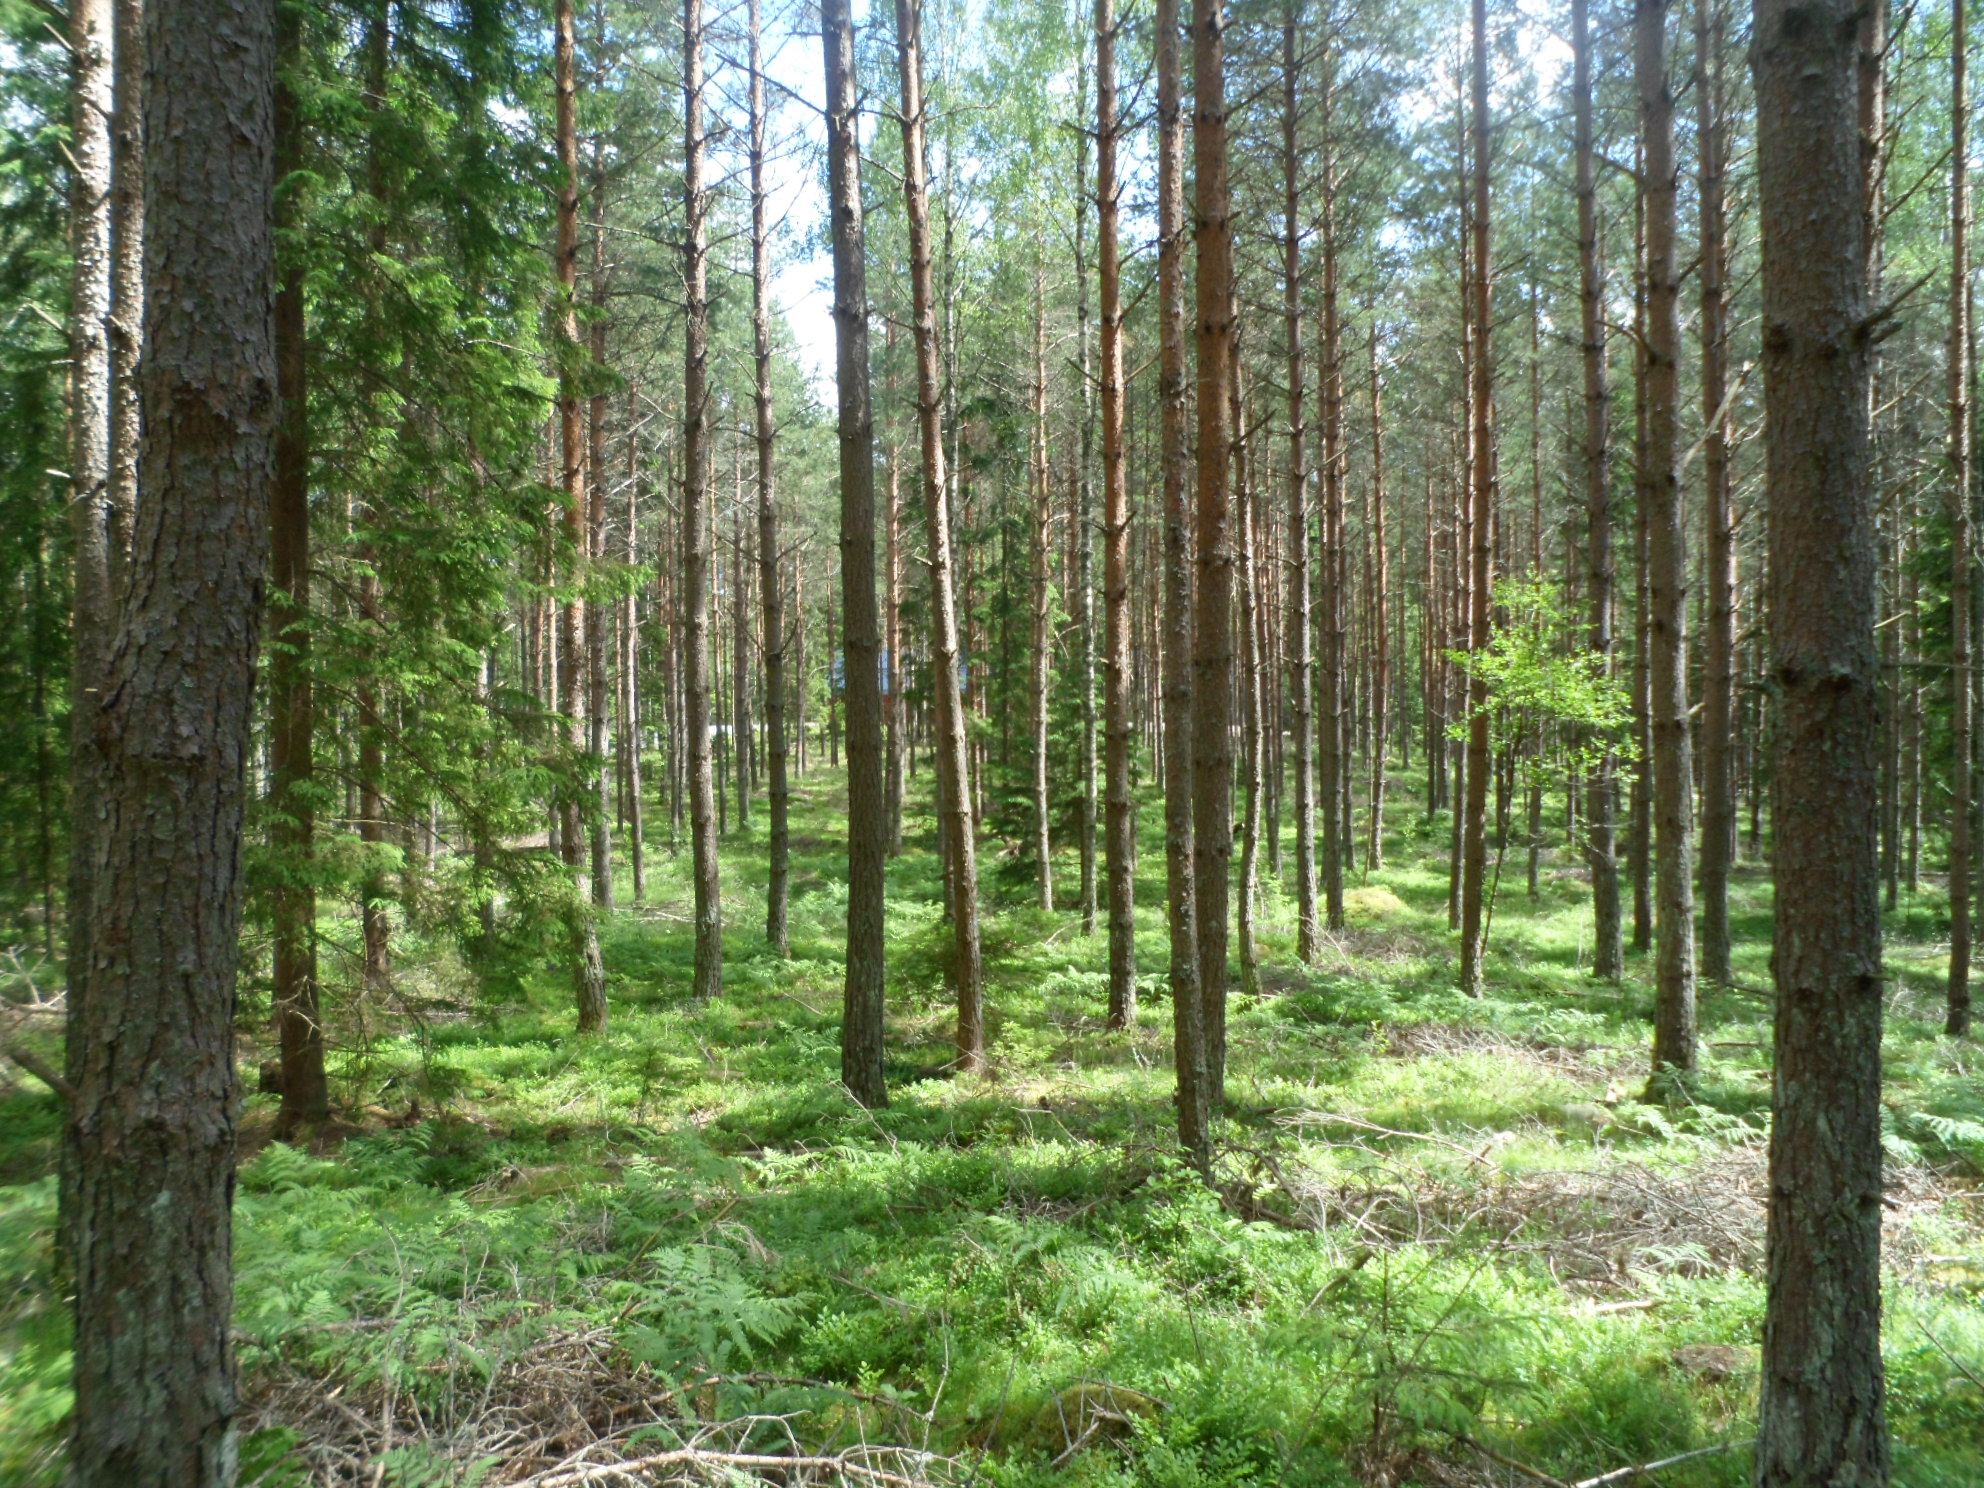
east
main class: Woodland
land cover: Pine dominated coniferous woodland
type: boreal forest
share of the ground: 50 - 75 %
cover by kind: coniferous forest trees 60 %, shrubs 20 %, lichens and mosses 15 %, herbaceous plants 5 %
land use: Forestry
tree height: > 5 m
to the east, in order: Pine dominated coniferous woodland; Artificial constructions in urban areas; Spruce dominated mixed woodland; Spruce dominated coniferous woodland; Ditches and canals; Groves; Paved roads, cycling and walking lanes
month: June
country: SE
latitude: 57.1056
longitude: 14.8340
